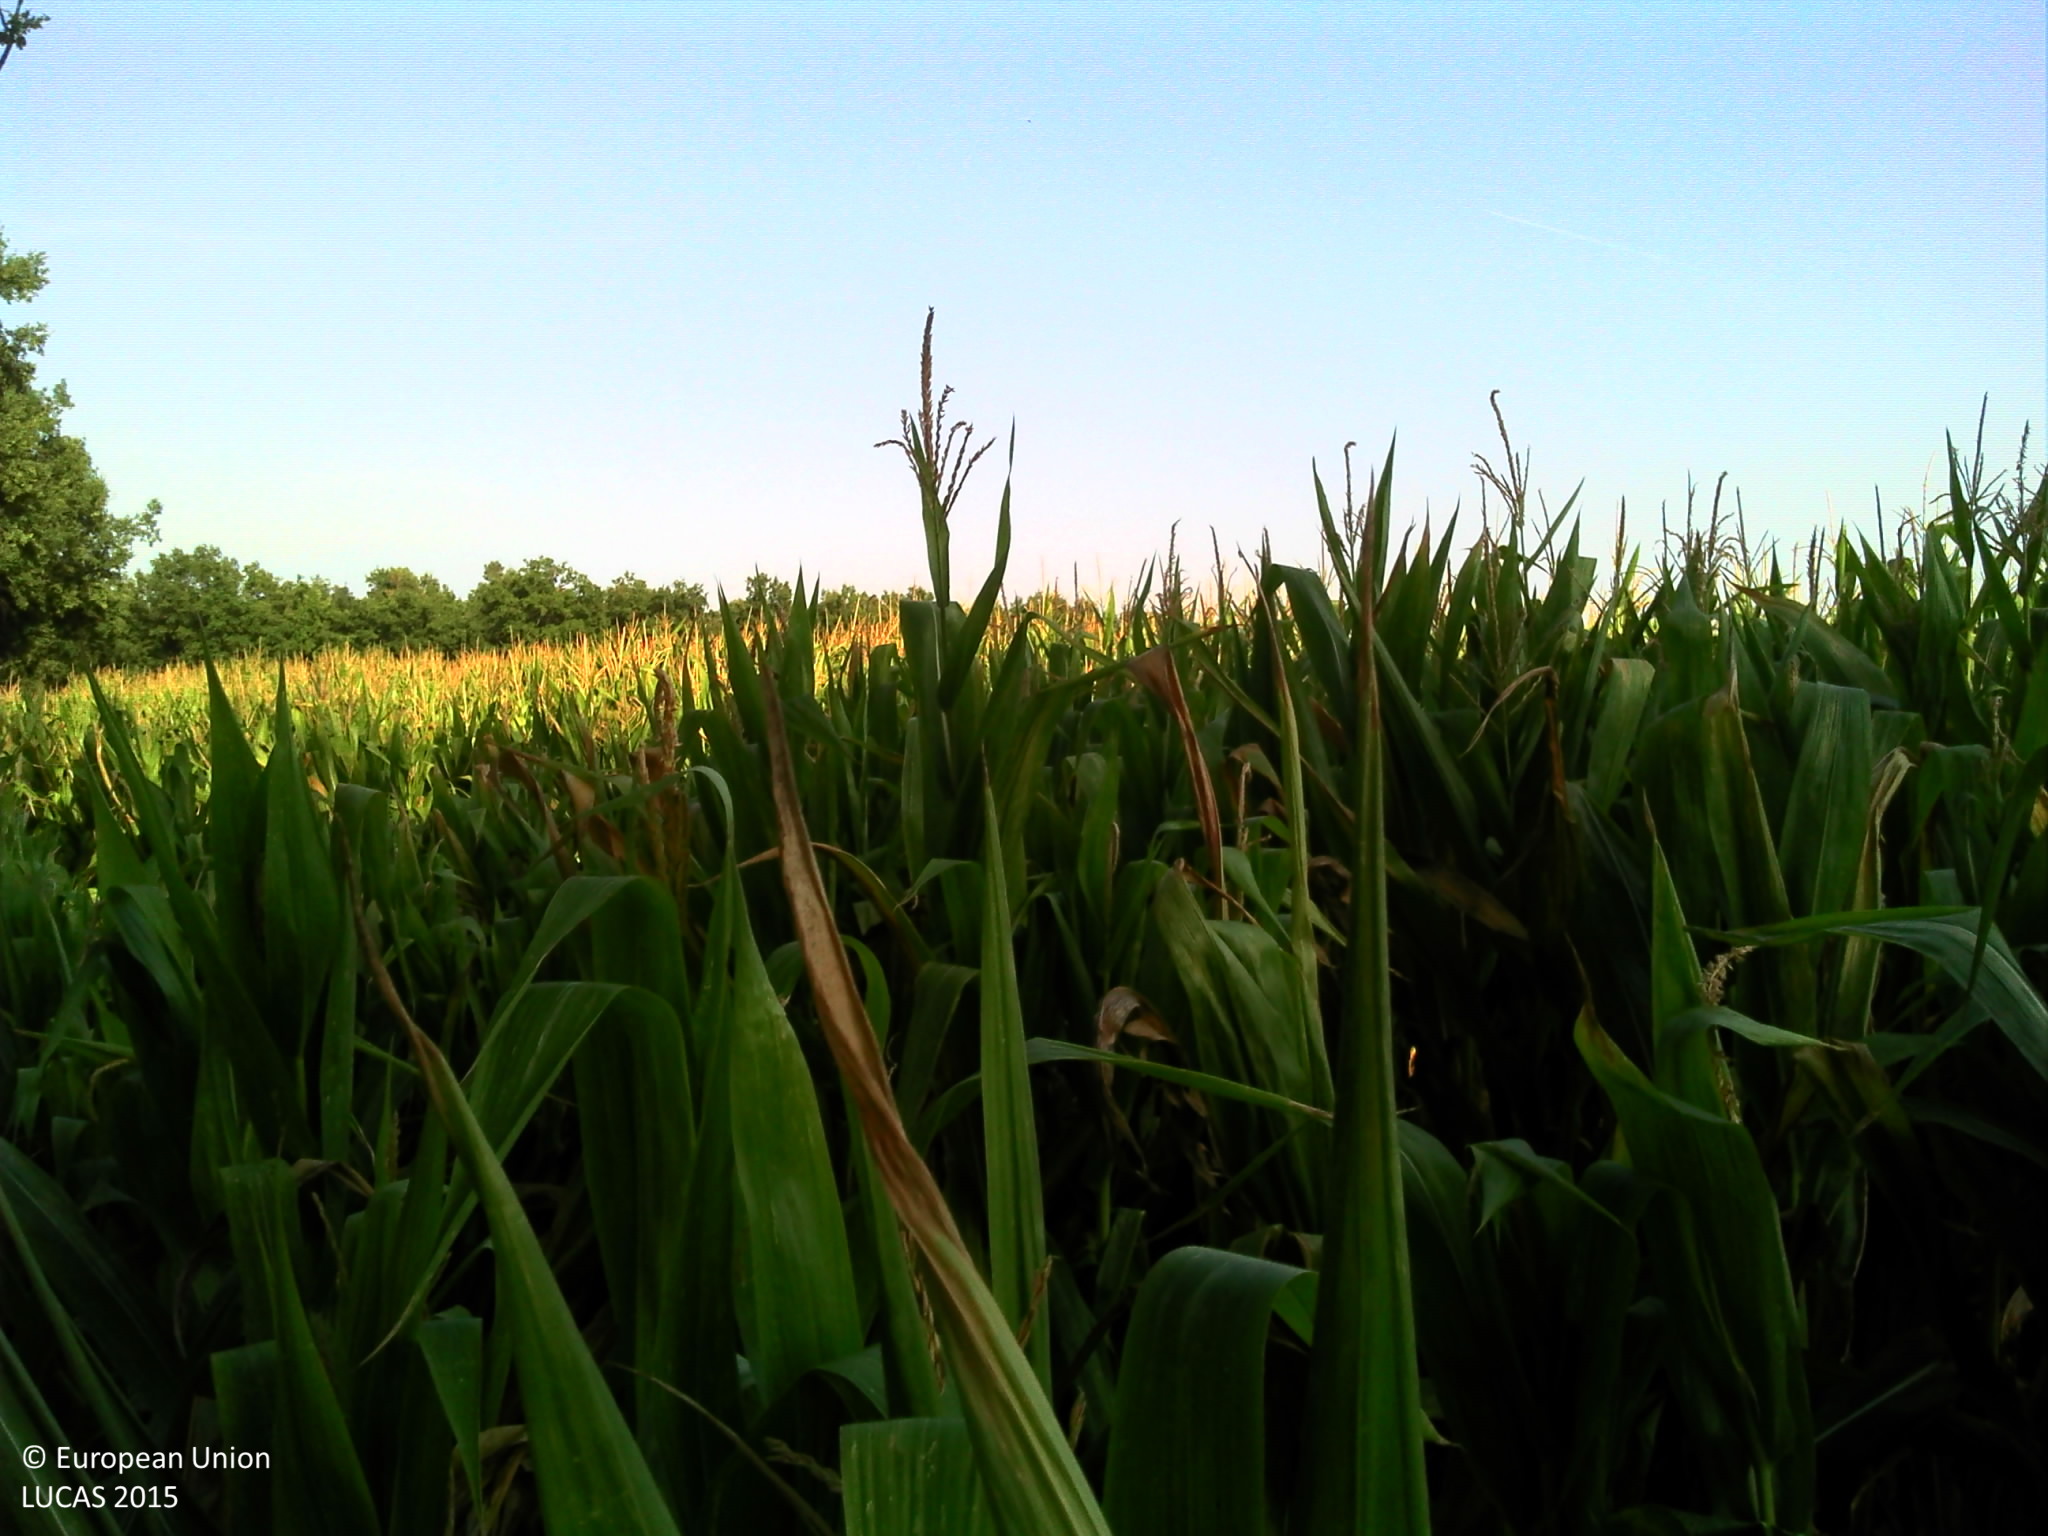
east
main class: Cropland
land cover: Maize
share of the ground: > 75 %
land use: Agriculture (excluding fallow land and kitchen gardens)
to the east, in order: Maize; Fences; Broadleaved woodland
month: August
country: FR
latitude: 45.6666
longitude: 4.1369
